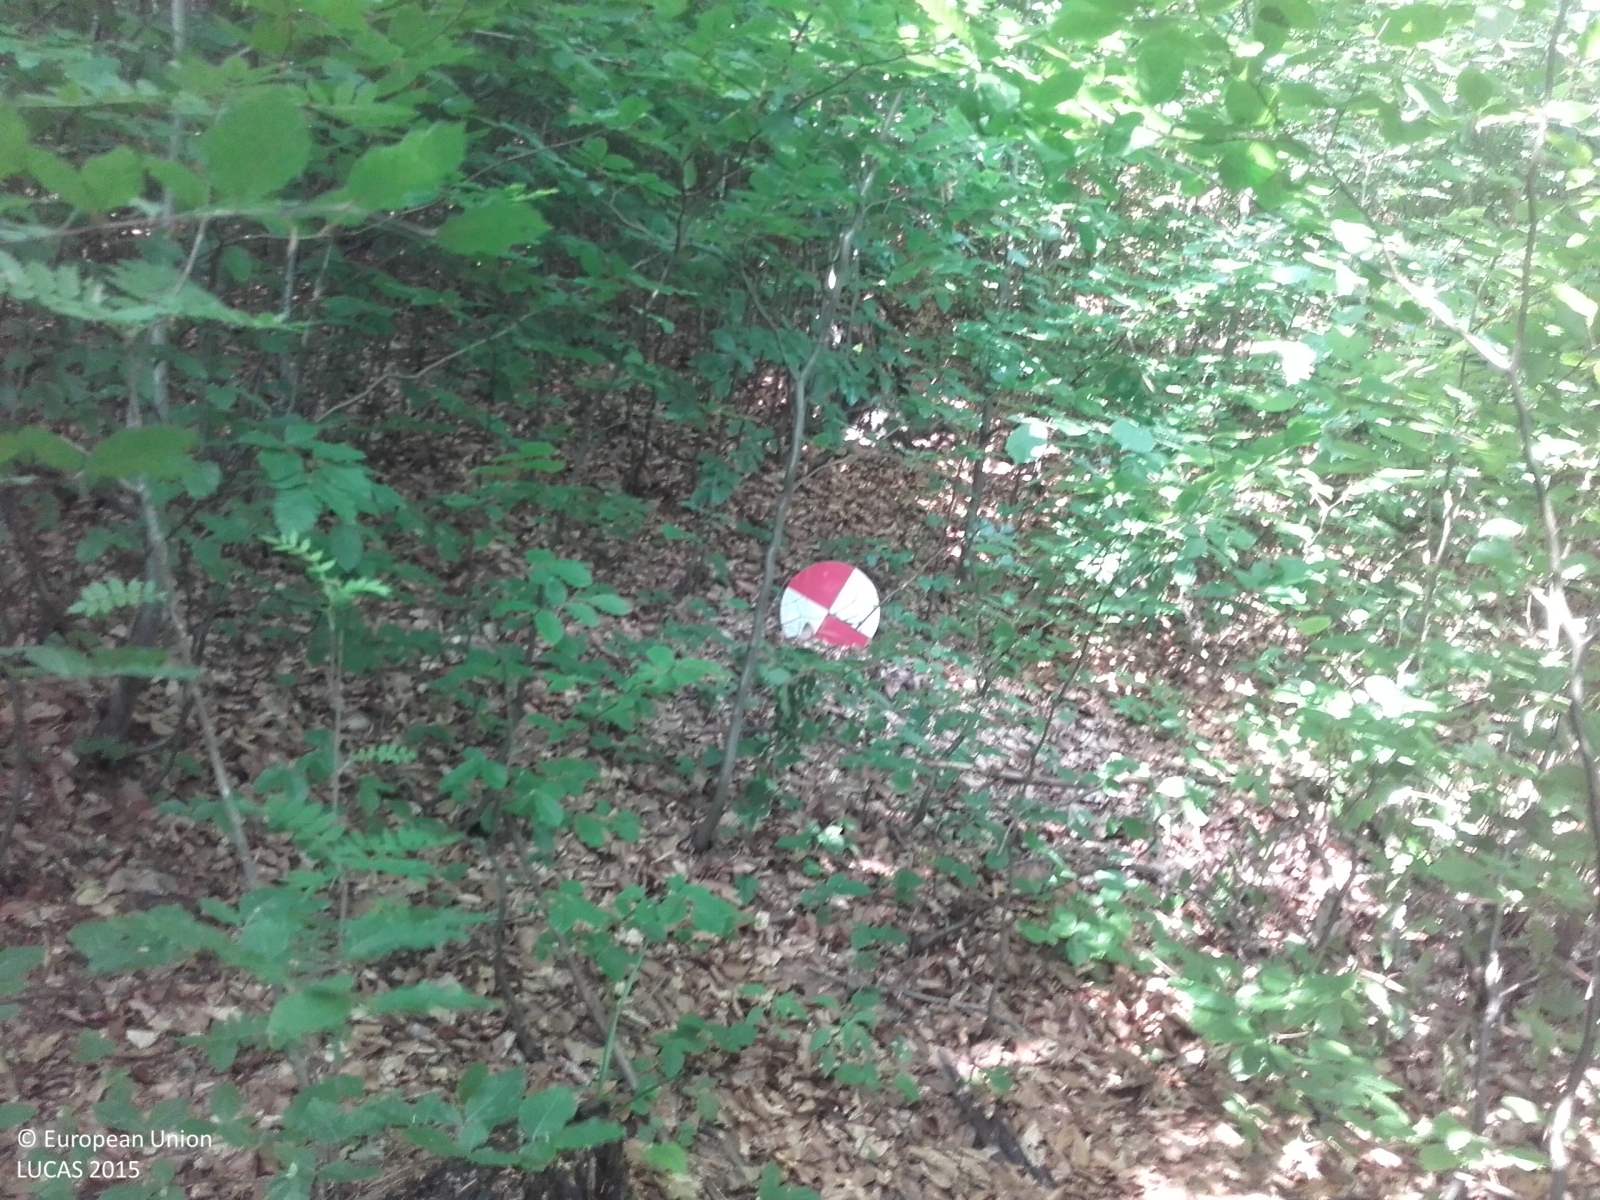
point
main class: Woodland
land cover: Broadleaved woodland
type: mesophytic deciduous forest
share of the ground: > 75 %
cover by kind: broadleaved forest trees 100 %
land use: Forestry
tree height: > 5 m
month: June
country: CZ
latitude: 49.6076
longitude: 18.8083
